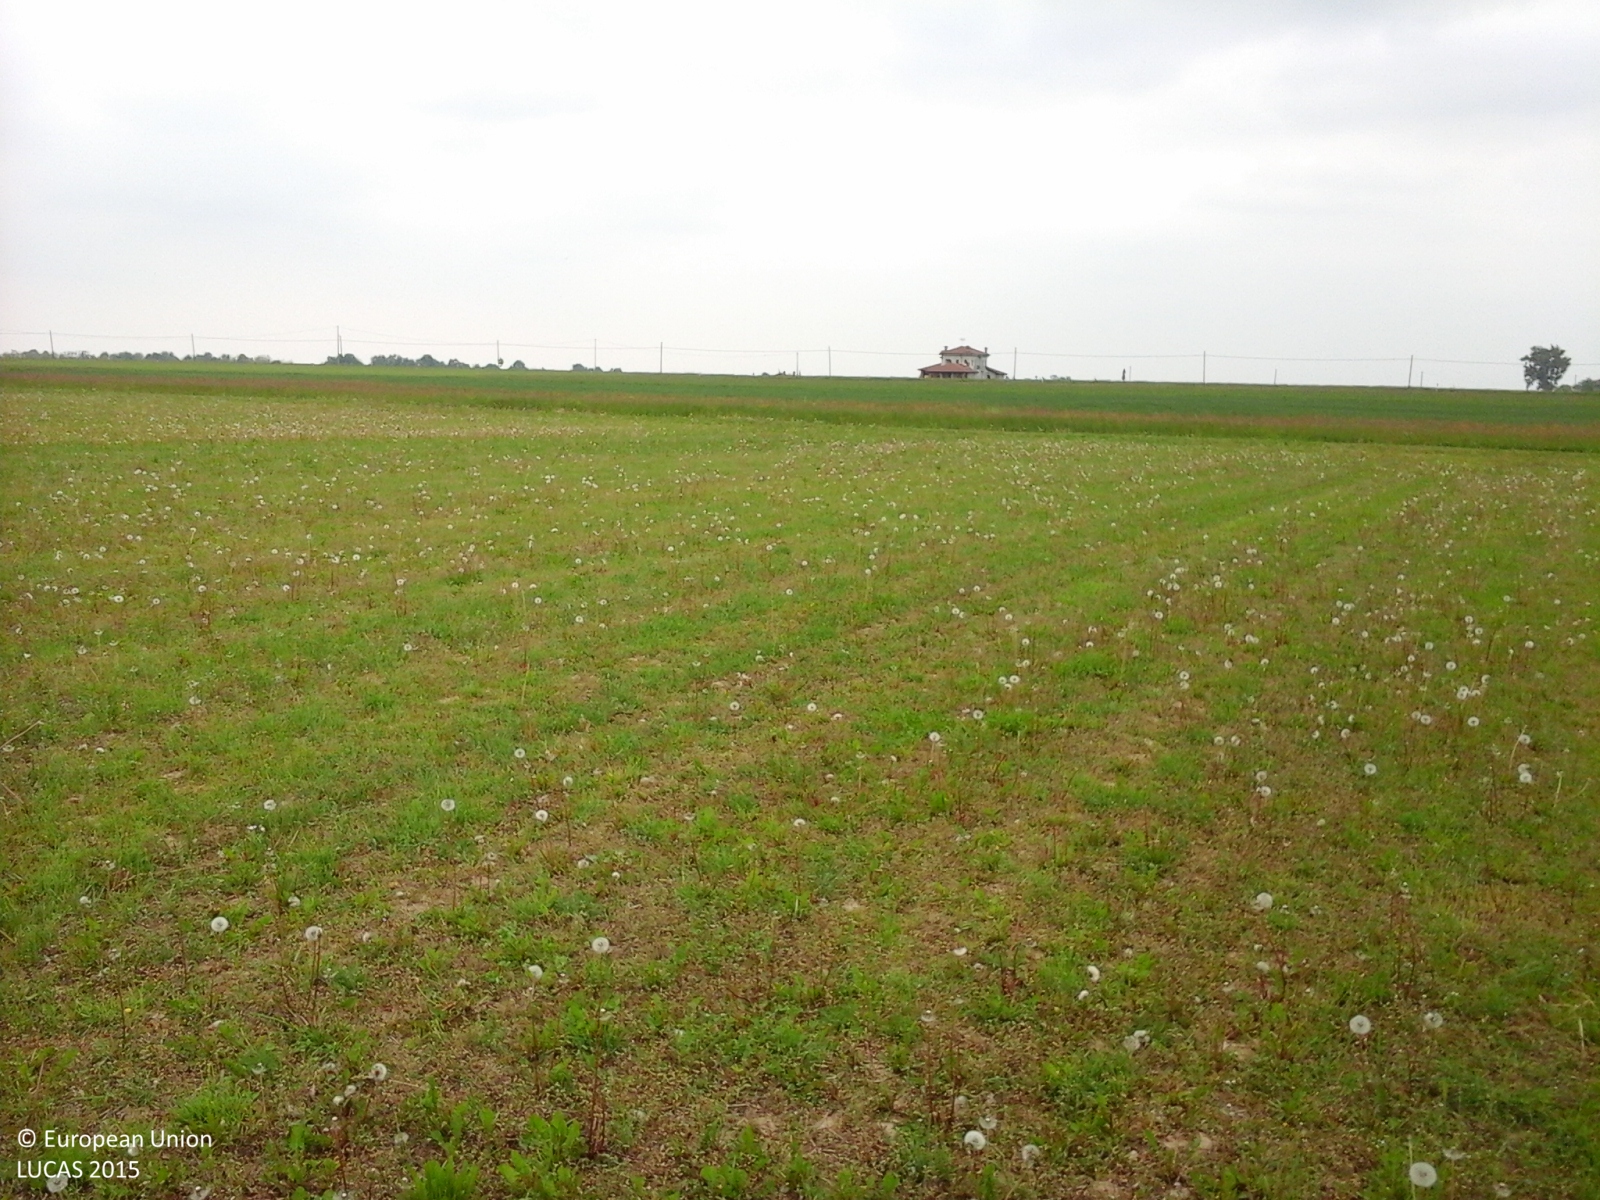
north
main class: Grassland
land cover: Spontaneously vegetated surfaces
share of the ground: 25 - 50 %
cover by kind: herbaceous plants 100 %
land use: Fallow land
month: May
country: IT
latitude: 44.5798
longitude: 7.8005
